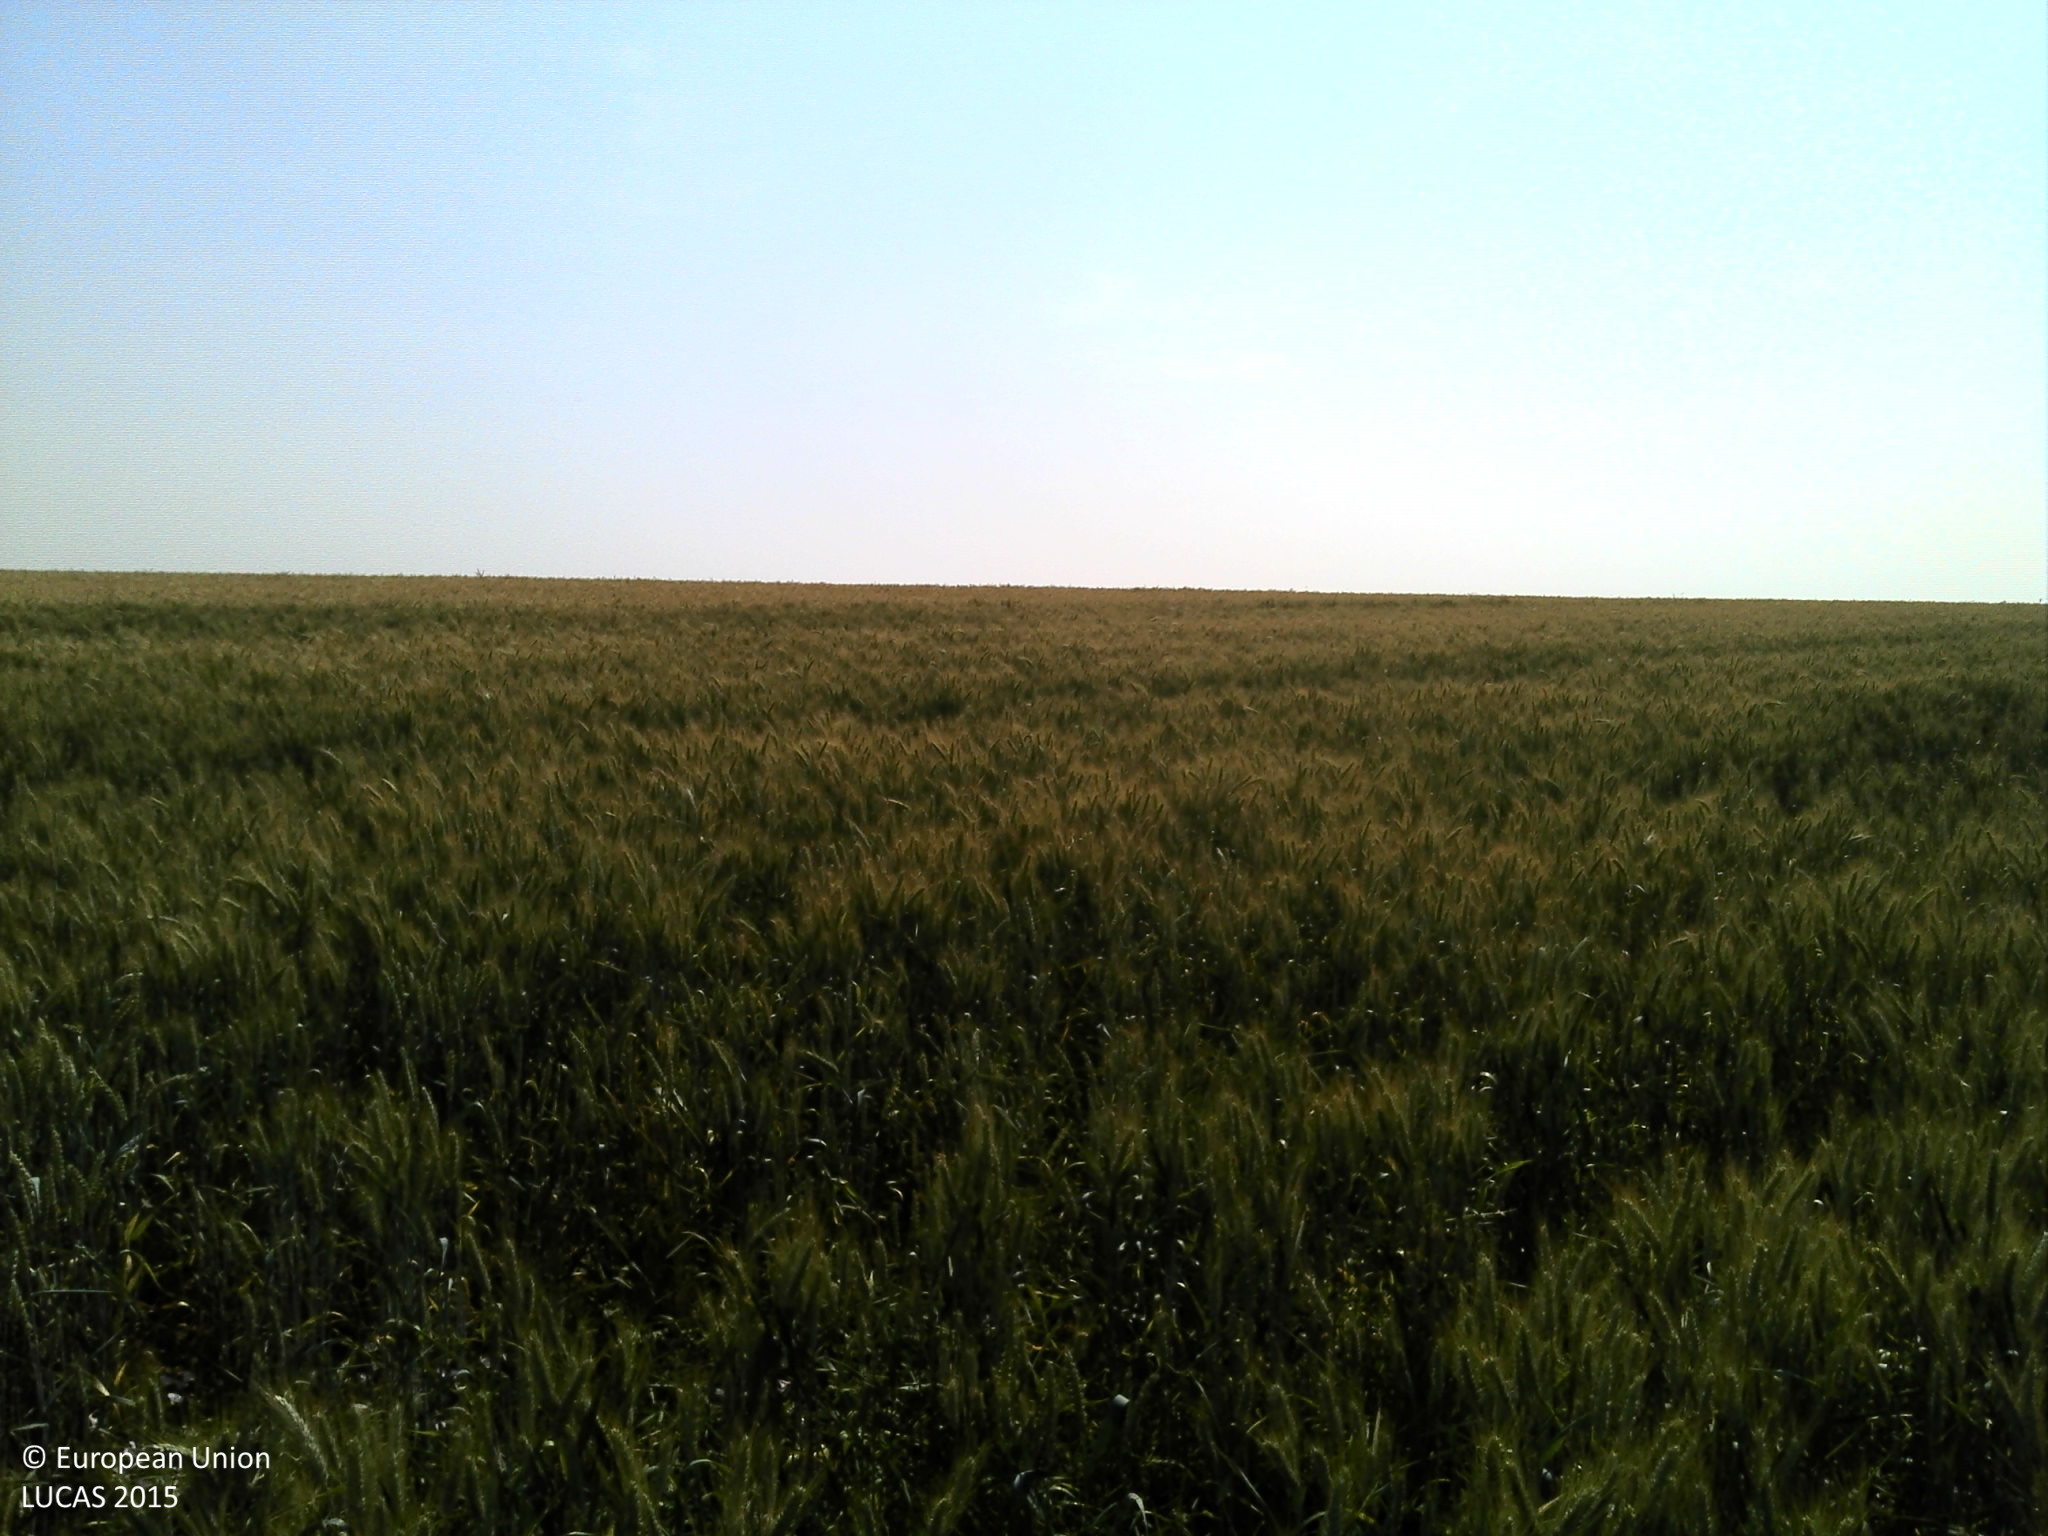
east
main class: Cropland
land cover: Triticale
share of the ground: > 75 %
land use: Agriculture (excluding fallow land and kitchen gardens)
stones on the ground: < 10 %
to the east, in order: Triticale; Grass margins; Tracks; Grass margins; Common wheat
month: July
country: FR
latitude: 49.8148
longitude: 4.4508
